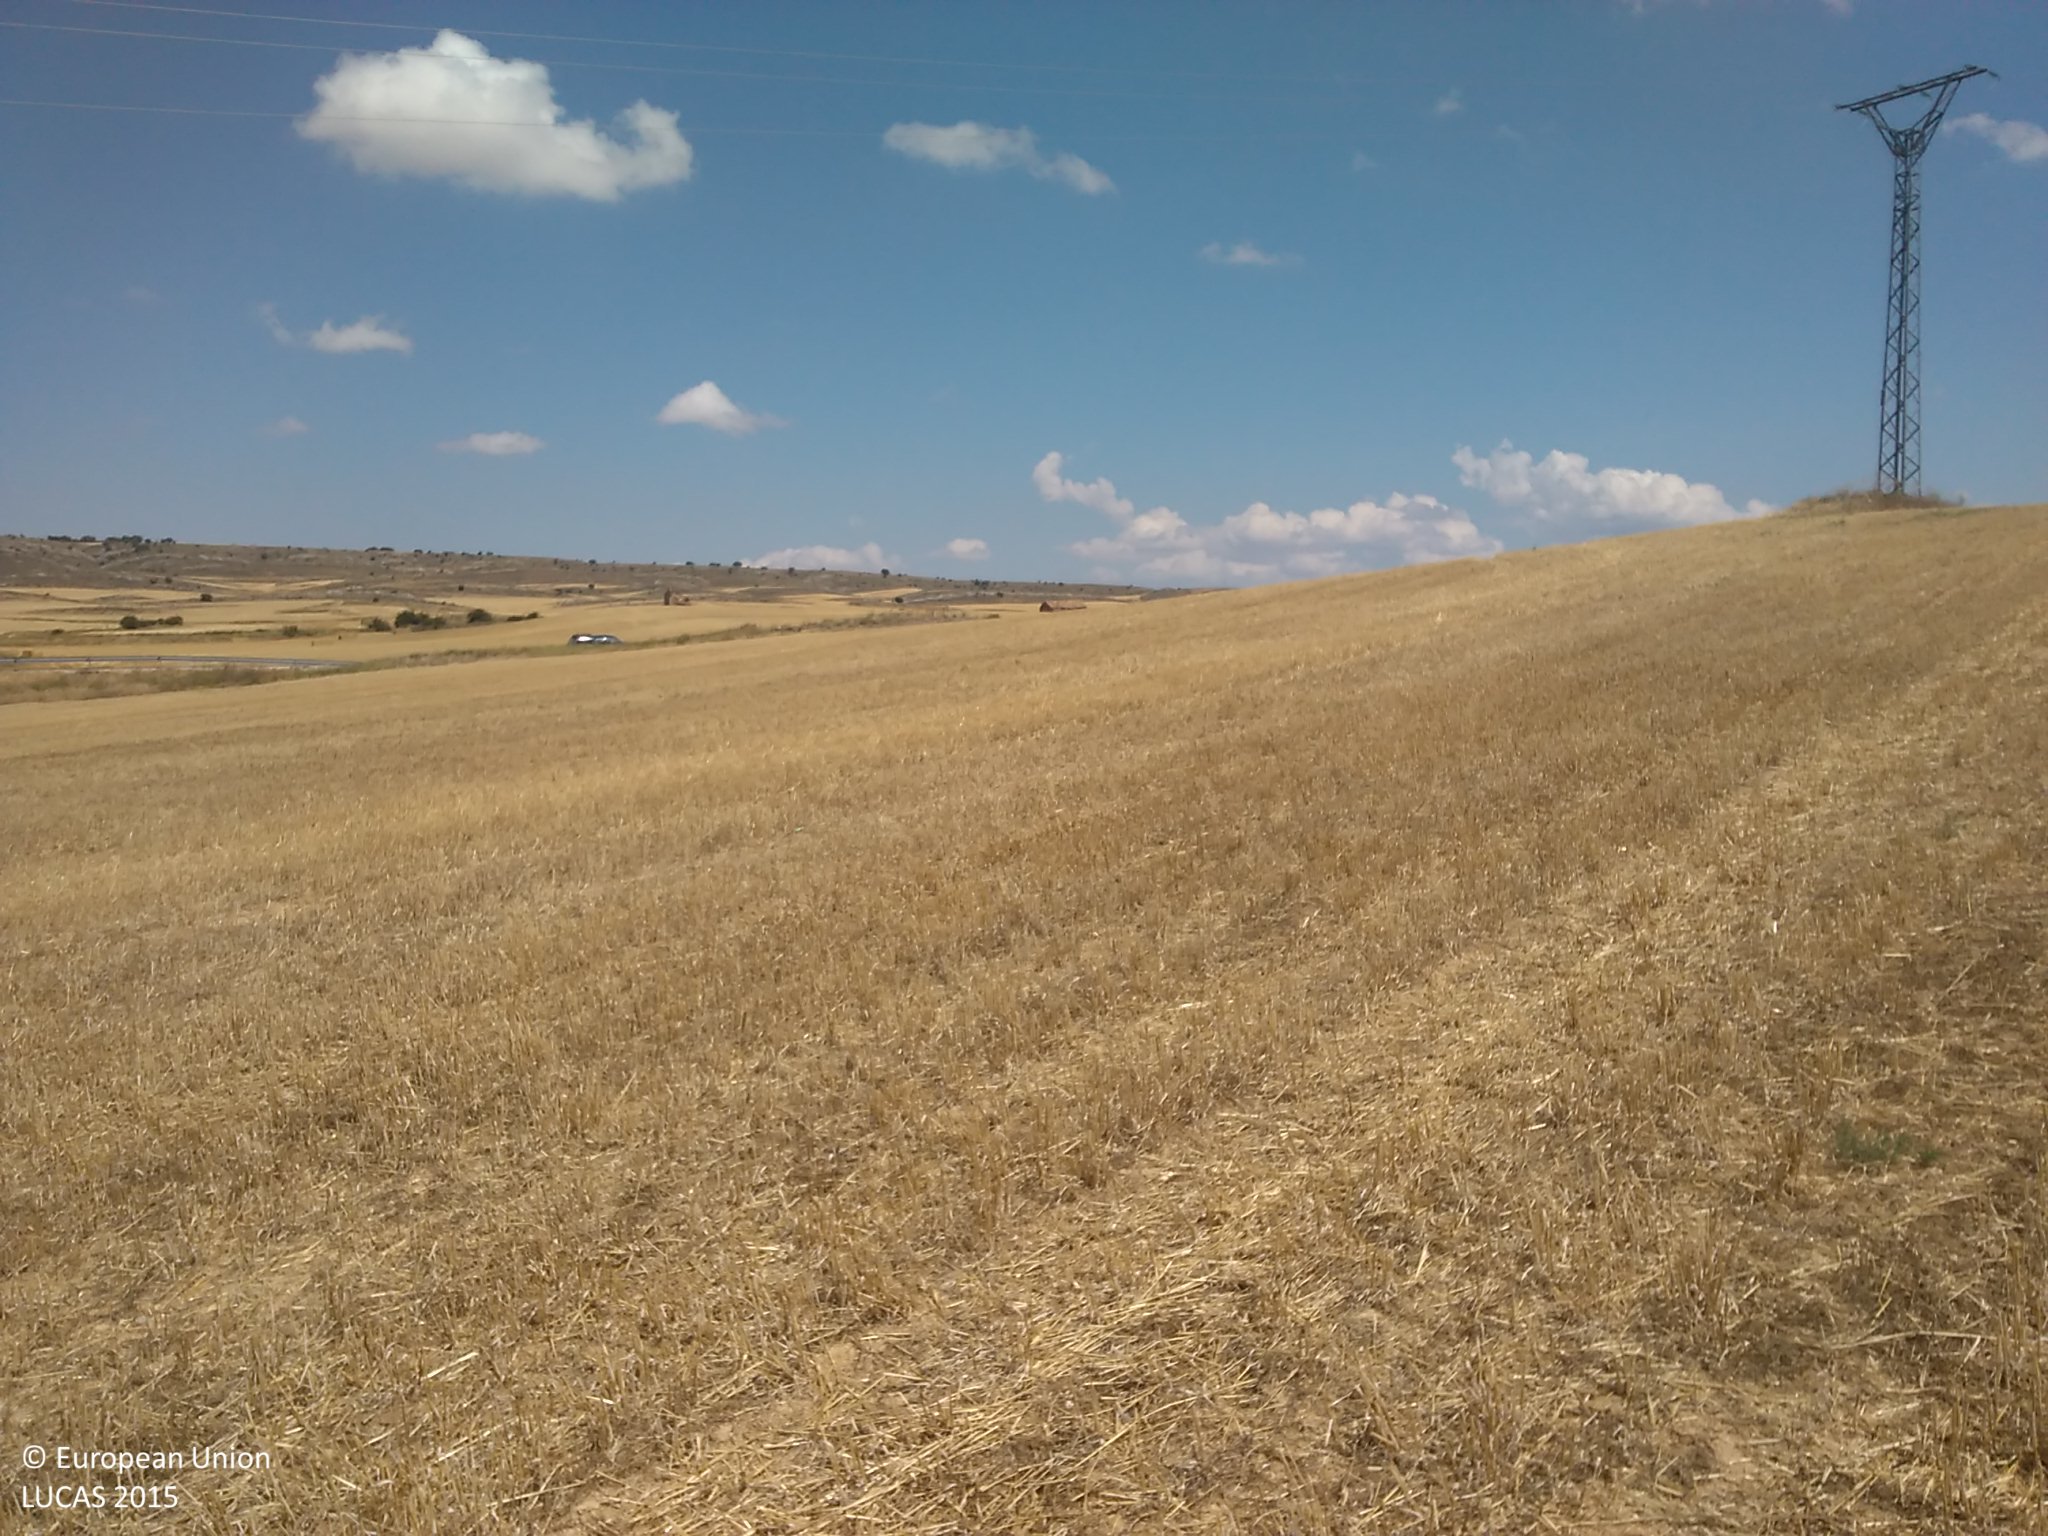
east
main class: Cropland
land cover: Barley
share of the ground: < 10 %
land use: Agriculture (excluding fallow land and kitchen gardens)
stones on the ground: < 10 %
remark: Harvested field
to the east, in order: Barley; Electric lines; Barley; Spontaneously vegetated surfaces; Paved roads, cycling and walking lanes; Shruby margins; Barley
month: July
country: ES
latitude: 41.6019
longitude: -2.2117
